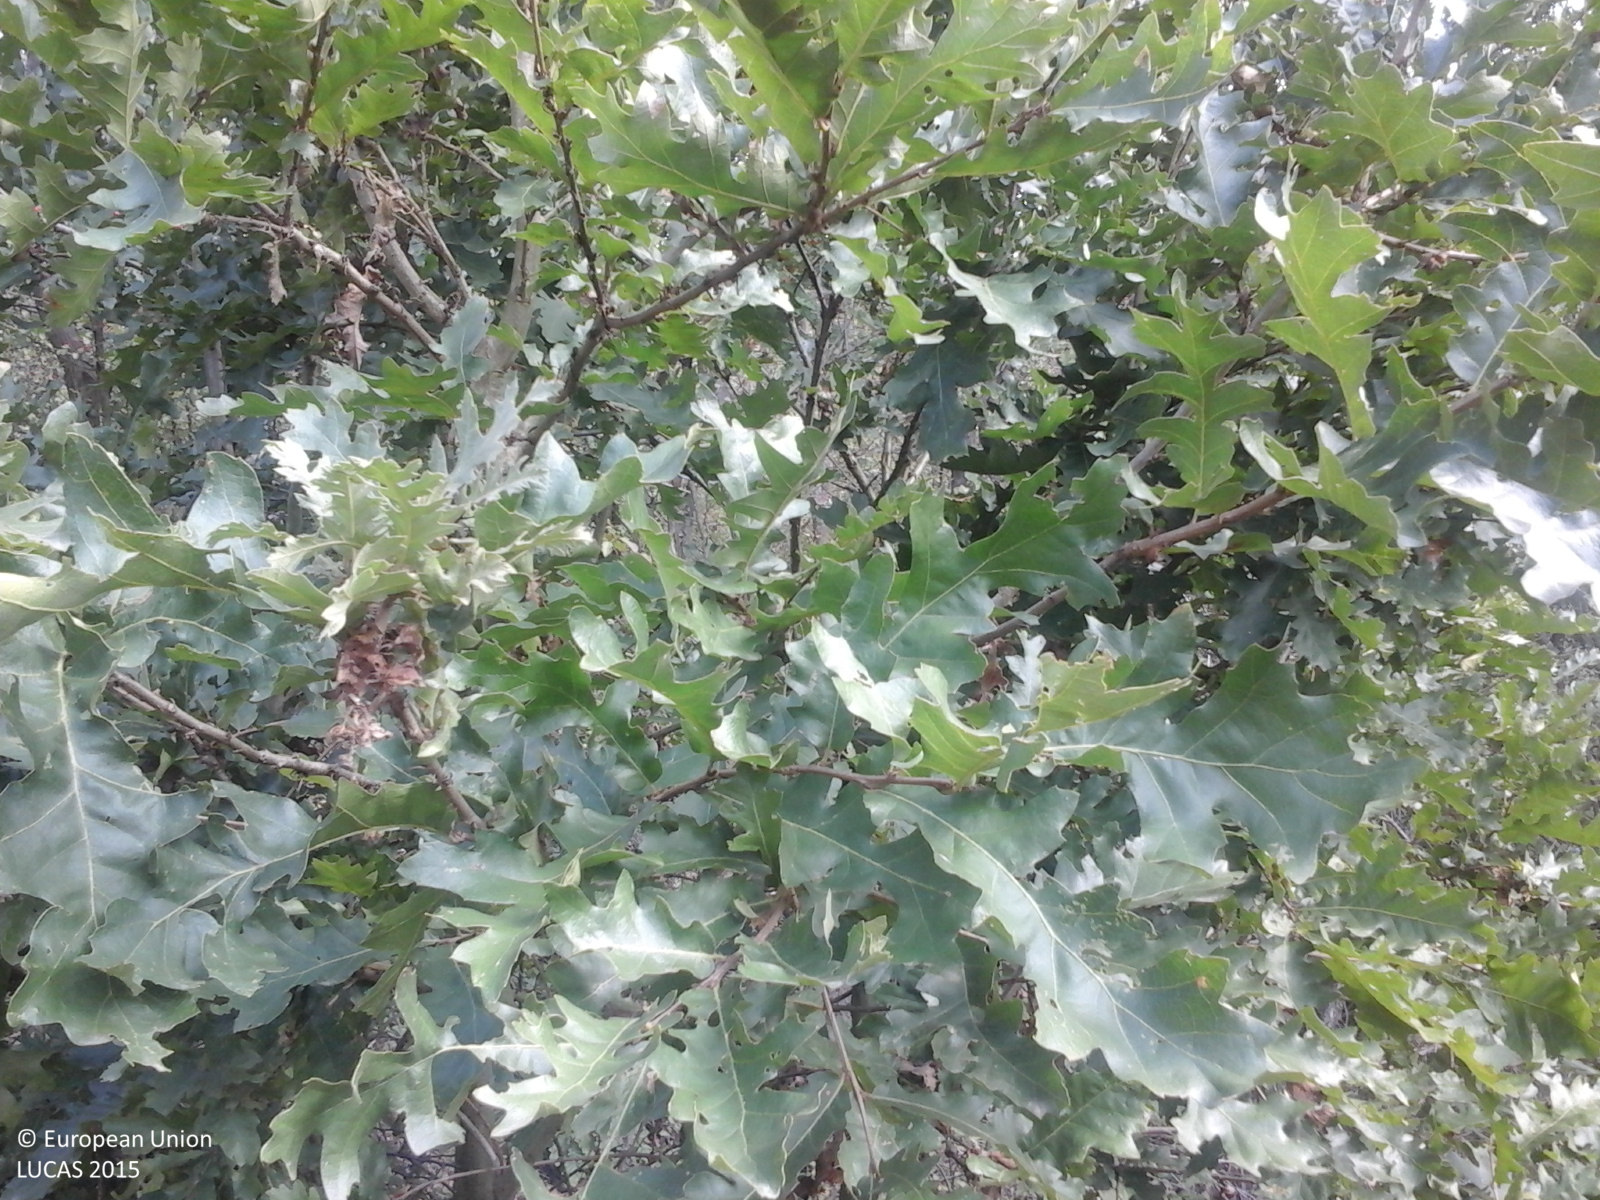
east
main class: Woodland
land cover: Broadleaved woodland
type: acidophilous oak and oak-birch forest
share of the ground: > 75 %
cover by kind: broadleaved forest trees 100 %
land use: Forestry
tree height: > 5 m
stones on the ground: < 10 %
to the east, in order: Broadleaved woodland
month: September
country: RO
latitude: 45.8177
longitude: 23.2248
